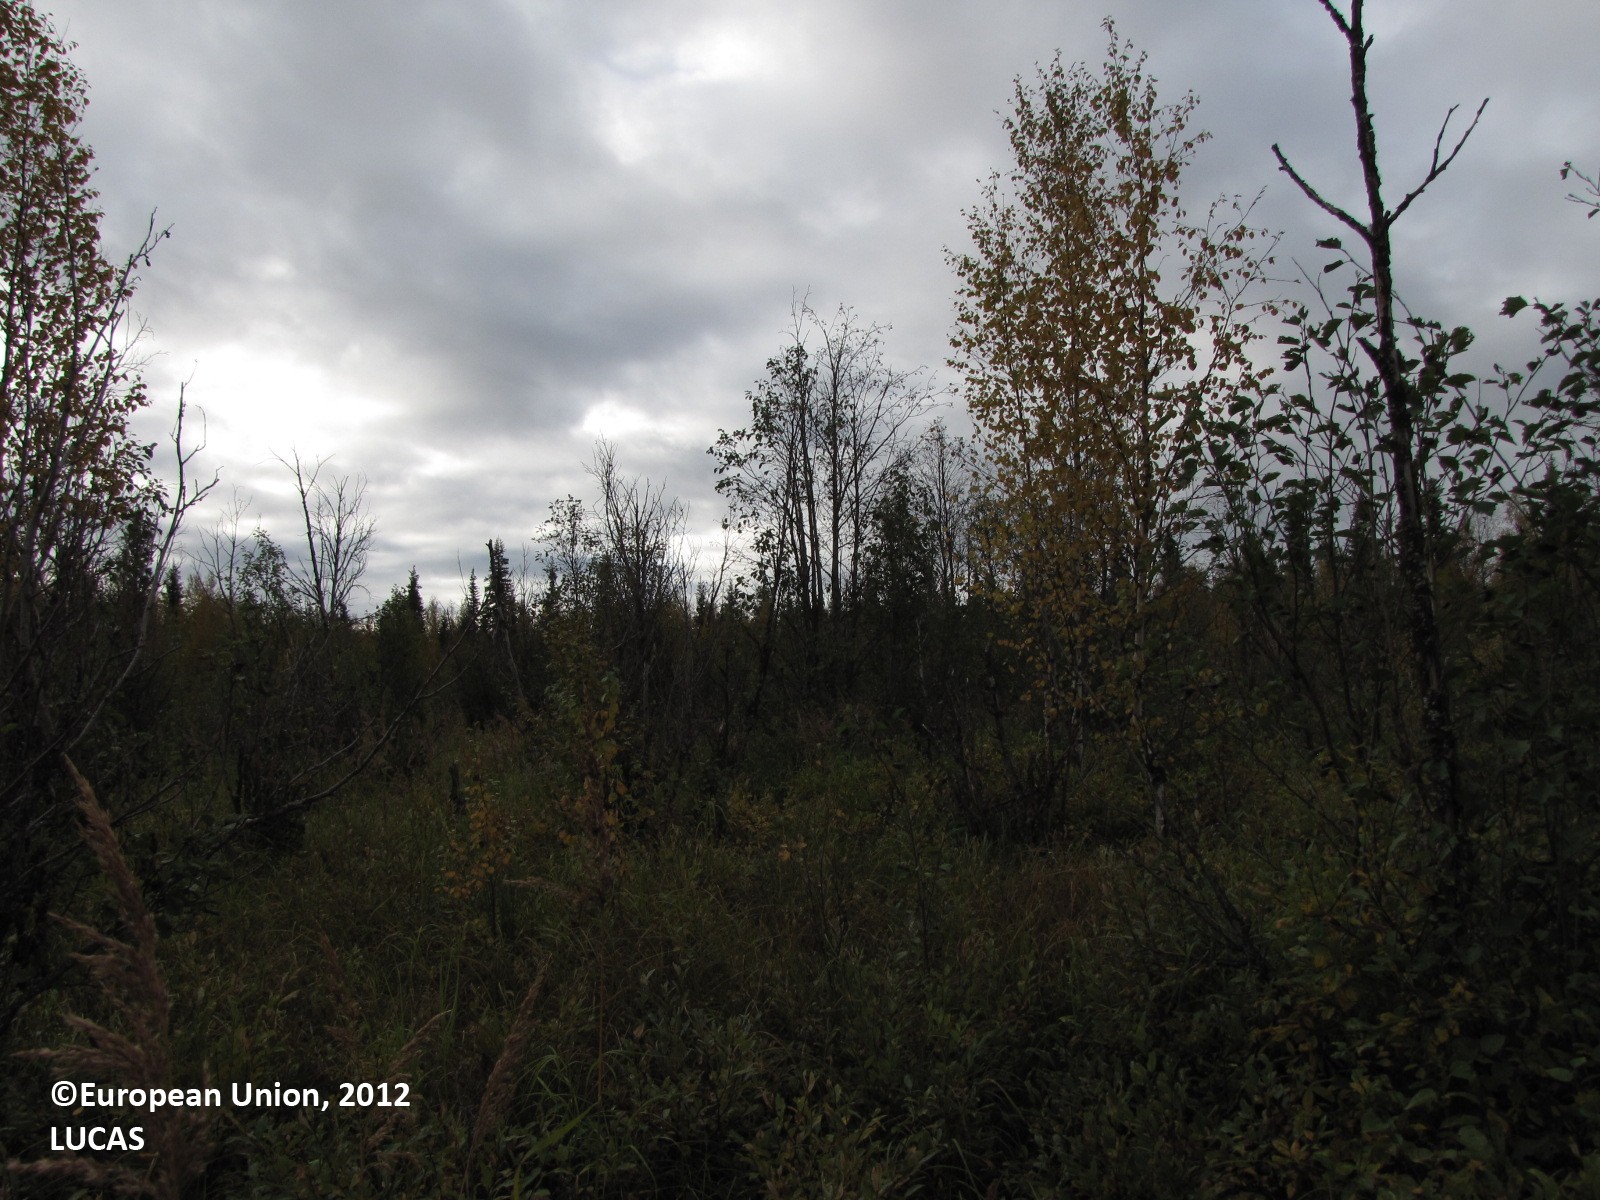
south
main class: Woodland
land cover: Broadleaved woodland
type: boreal forest
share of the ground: 10 - 25 %
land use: Forestry
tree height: > 5 m
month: September
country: FI
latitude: 67.1983
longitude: 23.5945
